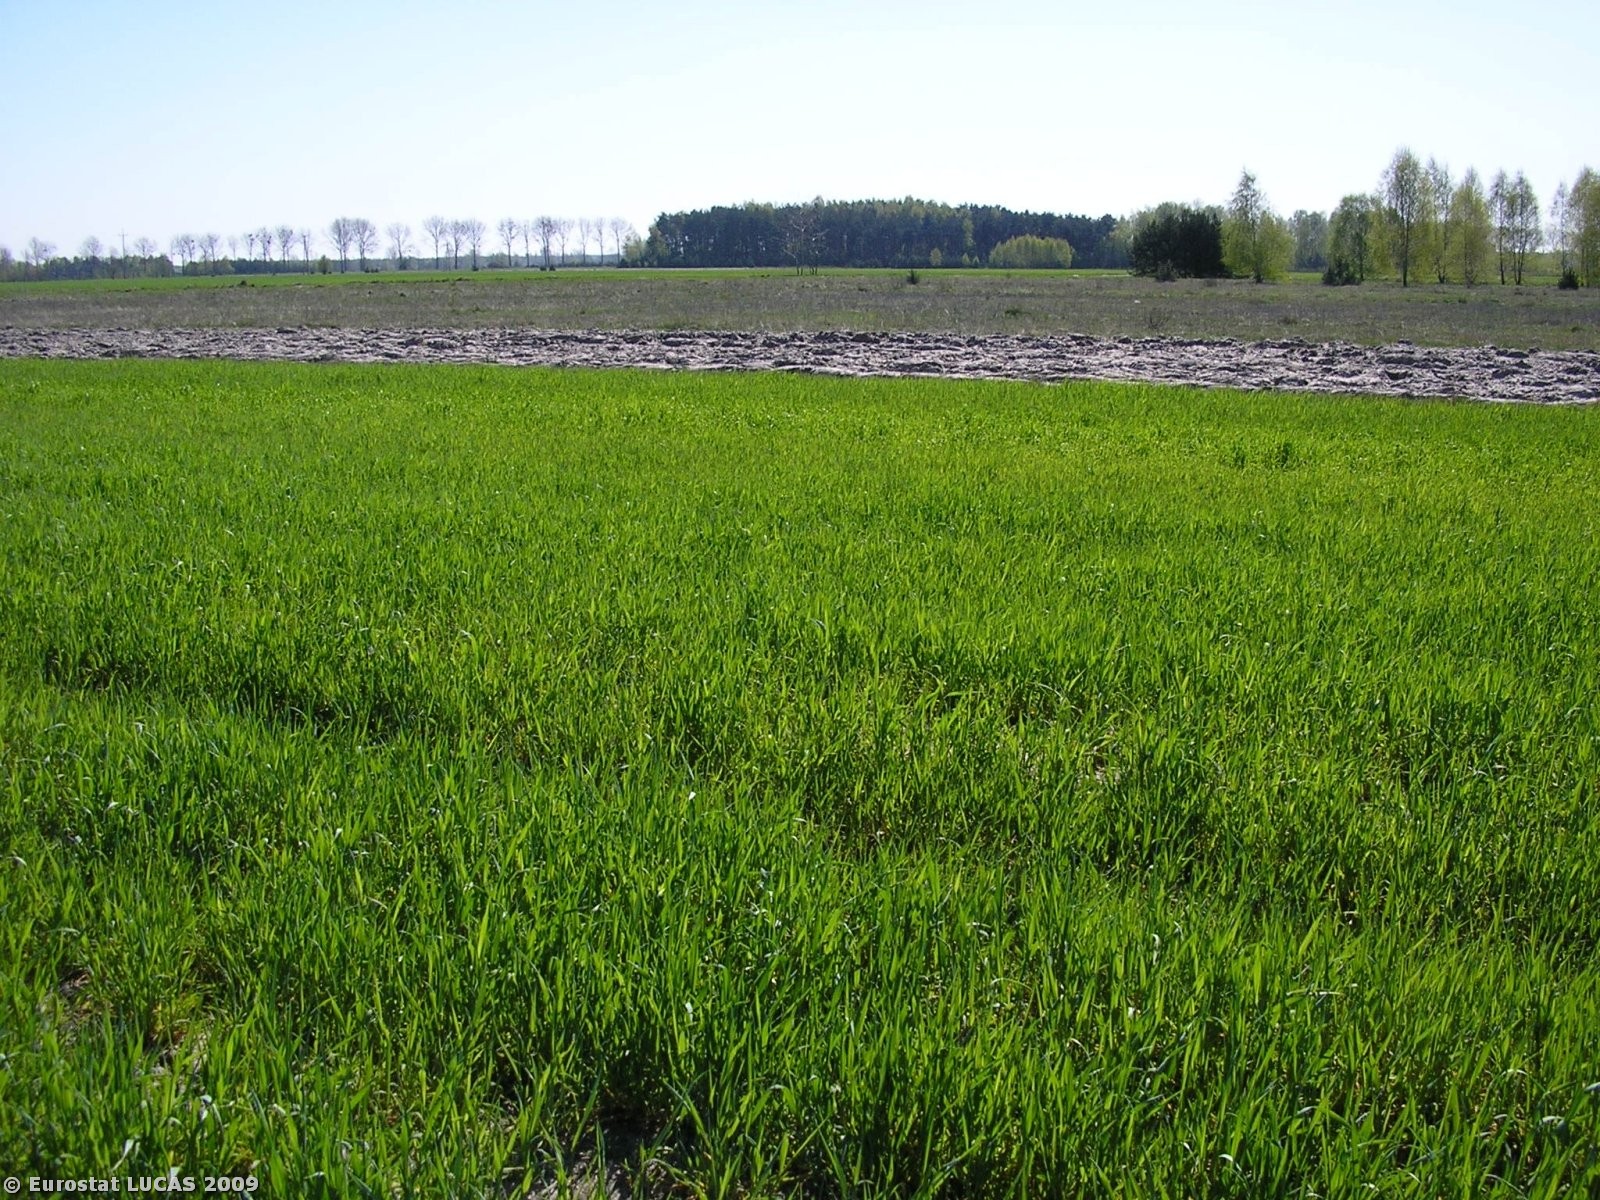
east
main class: Cropland
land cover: Rye
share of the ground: > 75 %
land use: Agriculture (excluding fallow land and kitchen gardens)
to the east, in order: Rye; Paved roads, cycling and walking lanes; Grass margins; Maize; Grassland without tree/shrub cover; Ditches and canals; Grassland without tree/shrub cover; Rye
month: April
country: PL
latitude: 52.1220
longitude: 20.1561
